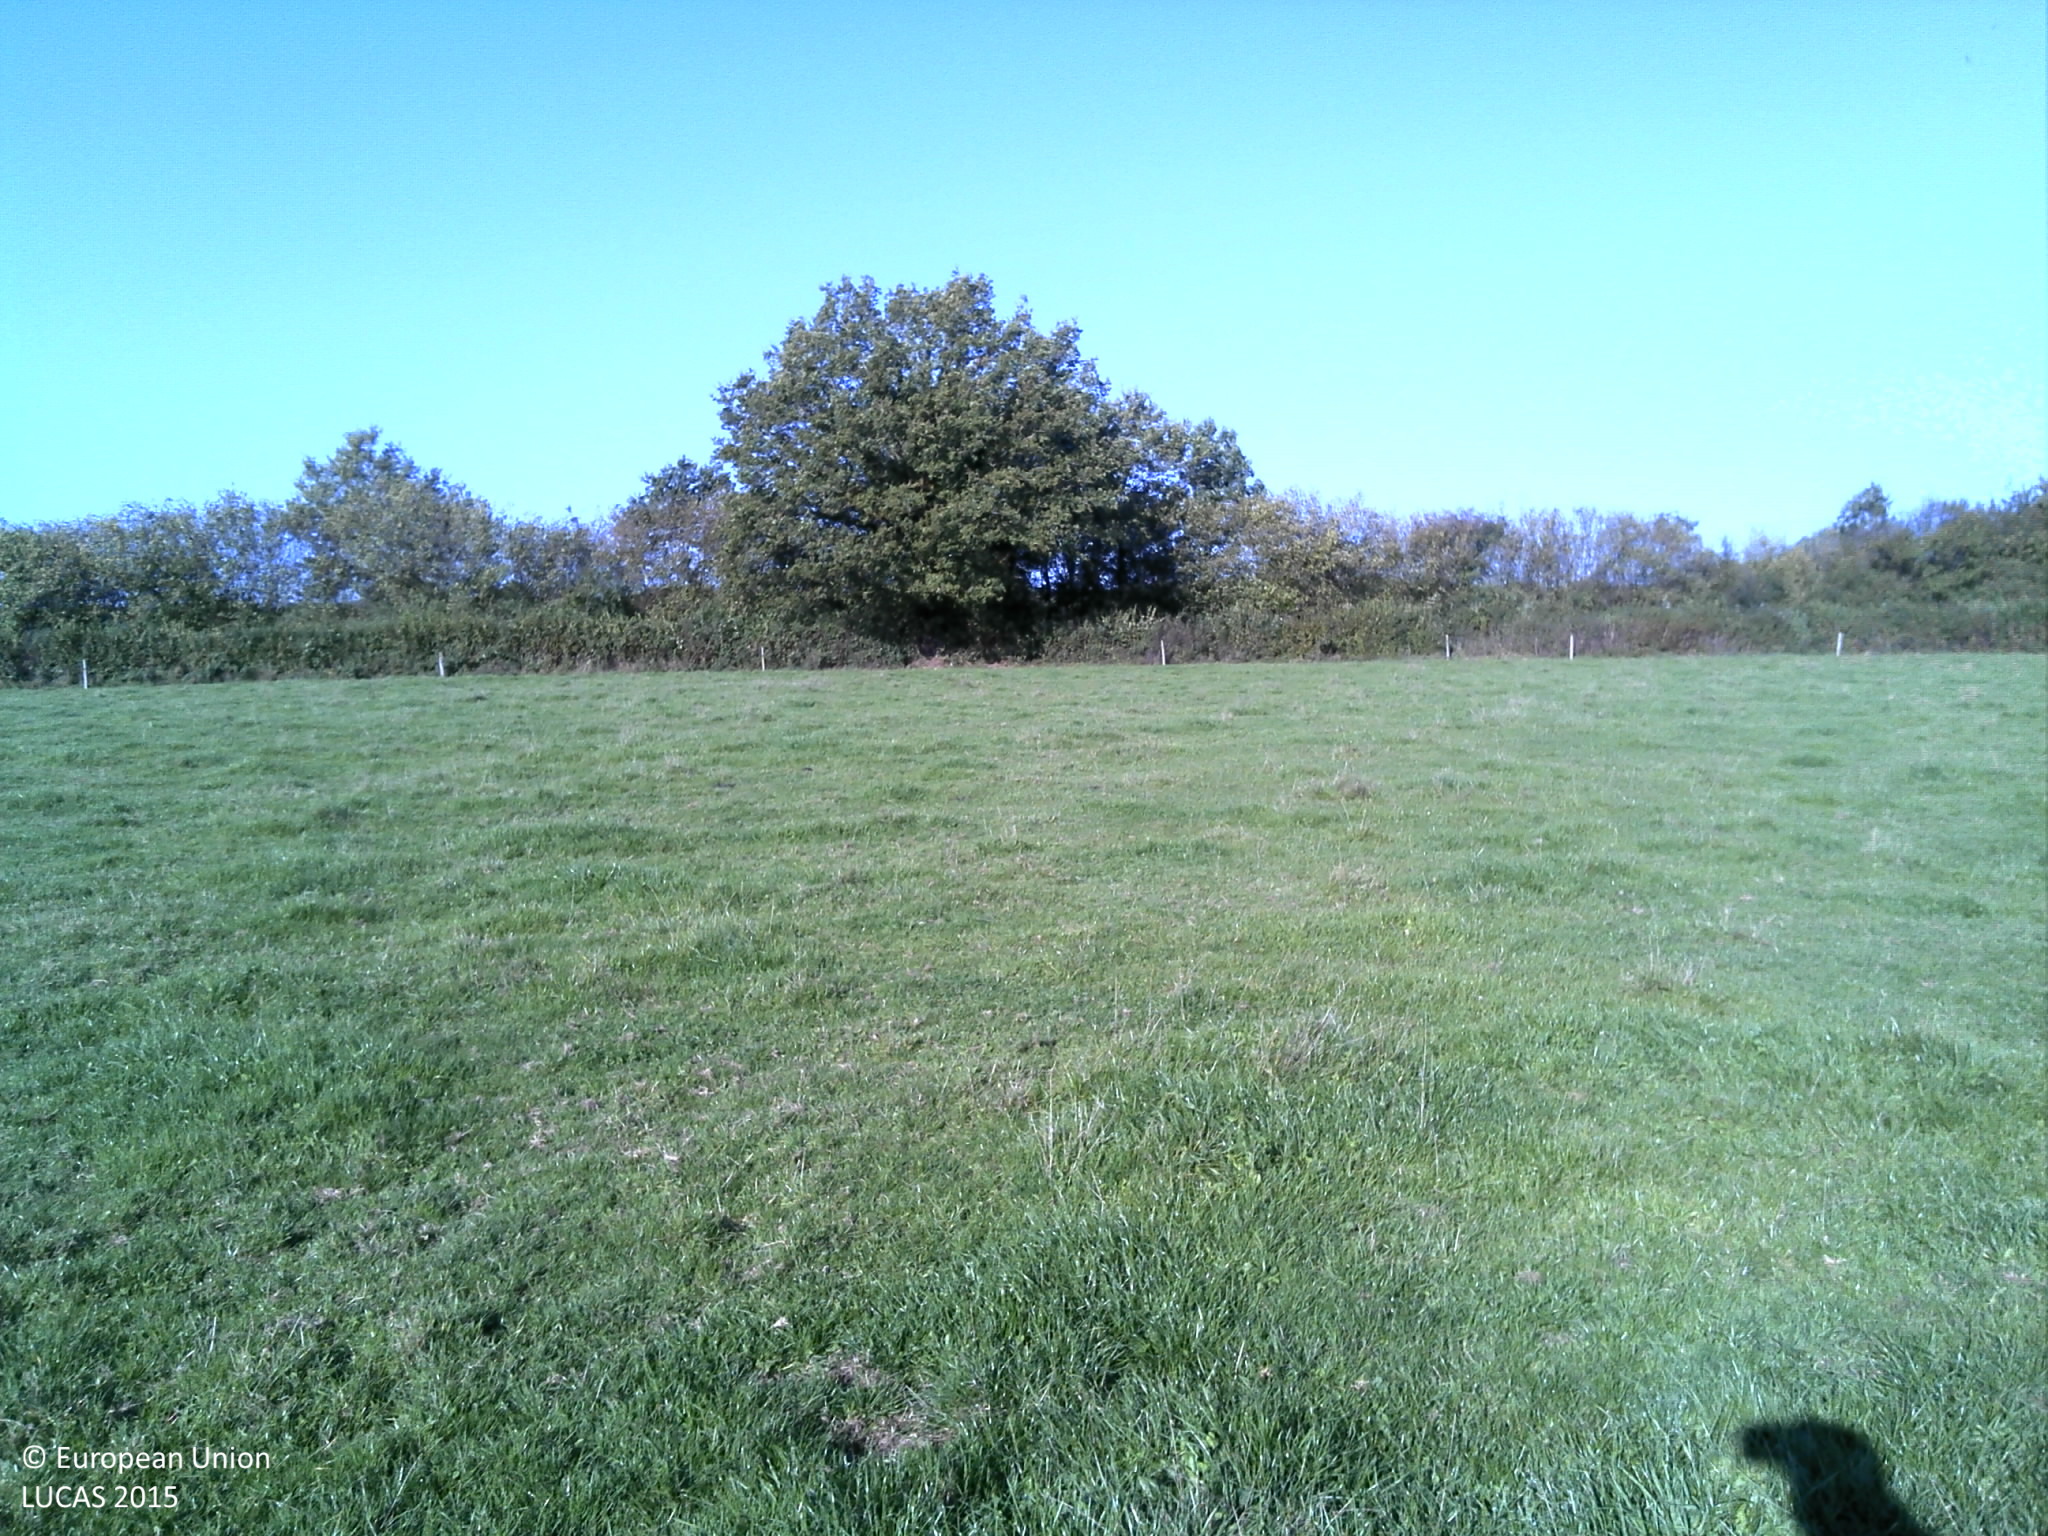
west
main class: Grassland
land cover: Grassland without tree/shrub cover
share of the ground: > 75 %
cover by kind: herbaceous plants 100 %
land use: Agriculture (excluding fallow land and kitchen gardens)
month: September
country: FR
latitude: 46.9261
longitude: 4.3923
